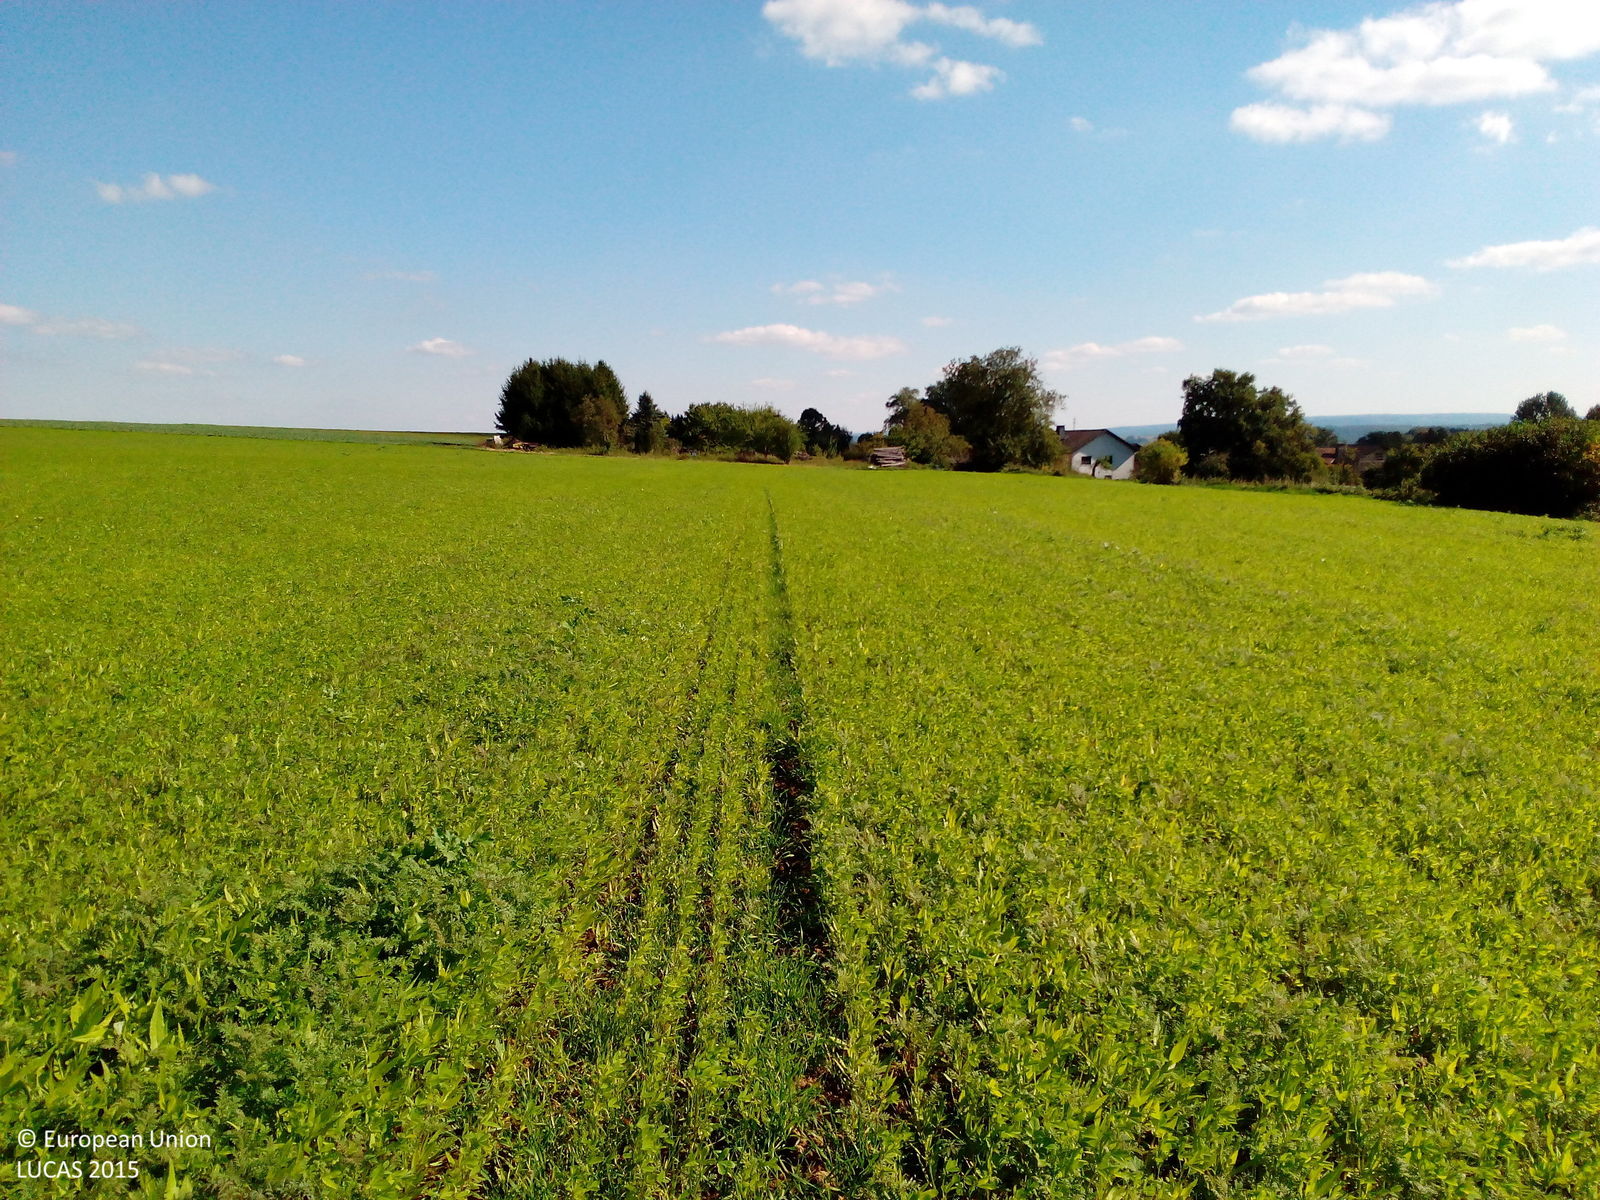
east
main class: Cropland
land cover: Other leguminous and mixtures for fodder
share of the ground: > 75 %
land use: Agriculture (excluding fallow land and kitchen gardens)
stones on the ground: < 10 %
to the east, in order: Other leguminous and mixtures for fodder; Grass margins; Tracks; Grass margins; Maize; Artificial constructions in urban areas; Apple fruit; Other bare soil; Grassland without tree/shrub cover; Spontaneously vegetated surfaces; Other structural elements; Spontaneously vegetated surfaces
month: September
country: DE
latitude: 50.3257
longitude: 9.2558
